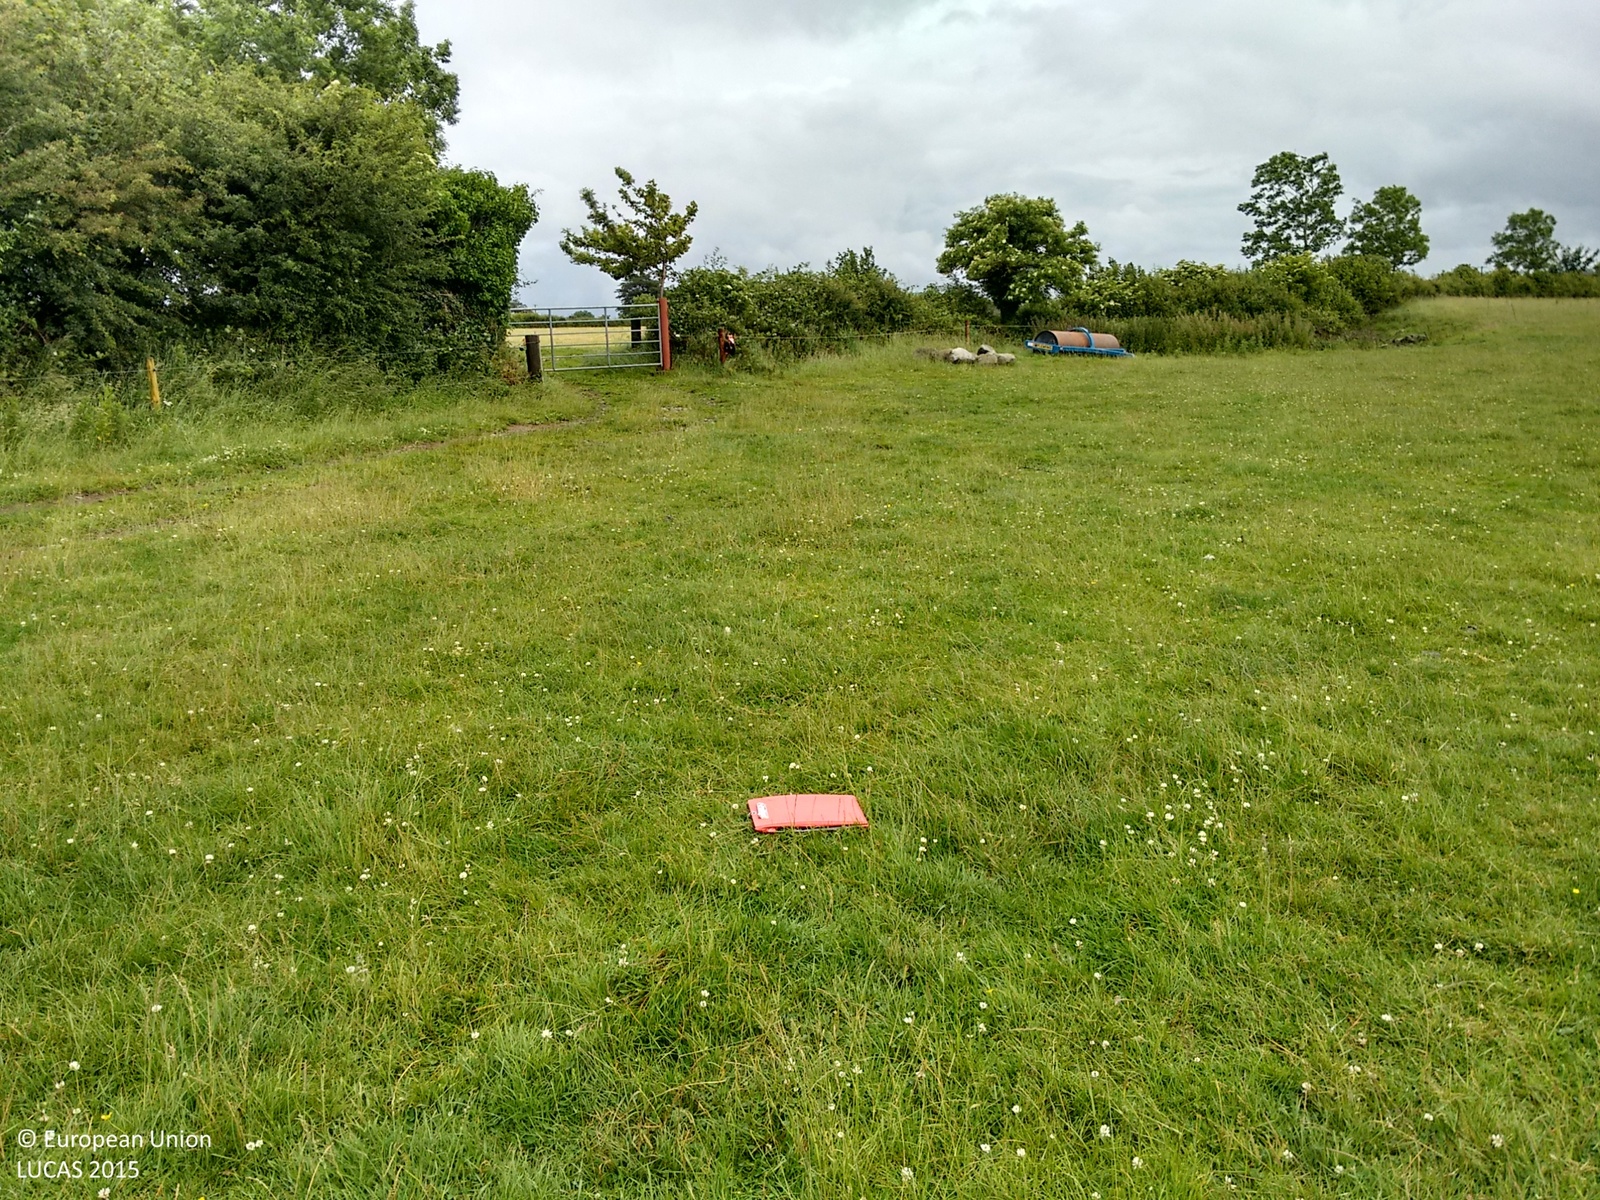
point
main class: Grassland
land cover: Grassland without tree/shrub cover
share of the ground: > 75 %
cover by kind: herbaceous plants 100 %
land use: Agriculture (excluding fallow land and kitchen gardens)
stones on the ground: < 10 %
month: July
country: IE
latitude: 53.6536
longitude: -8.0453
